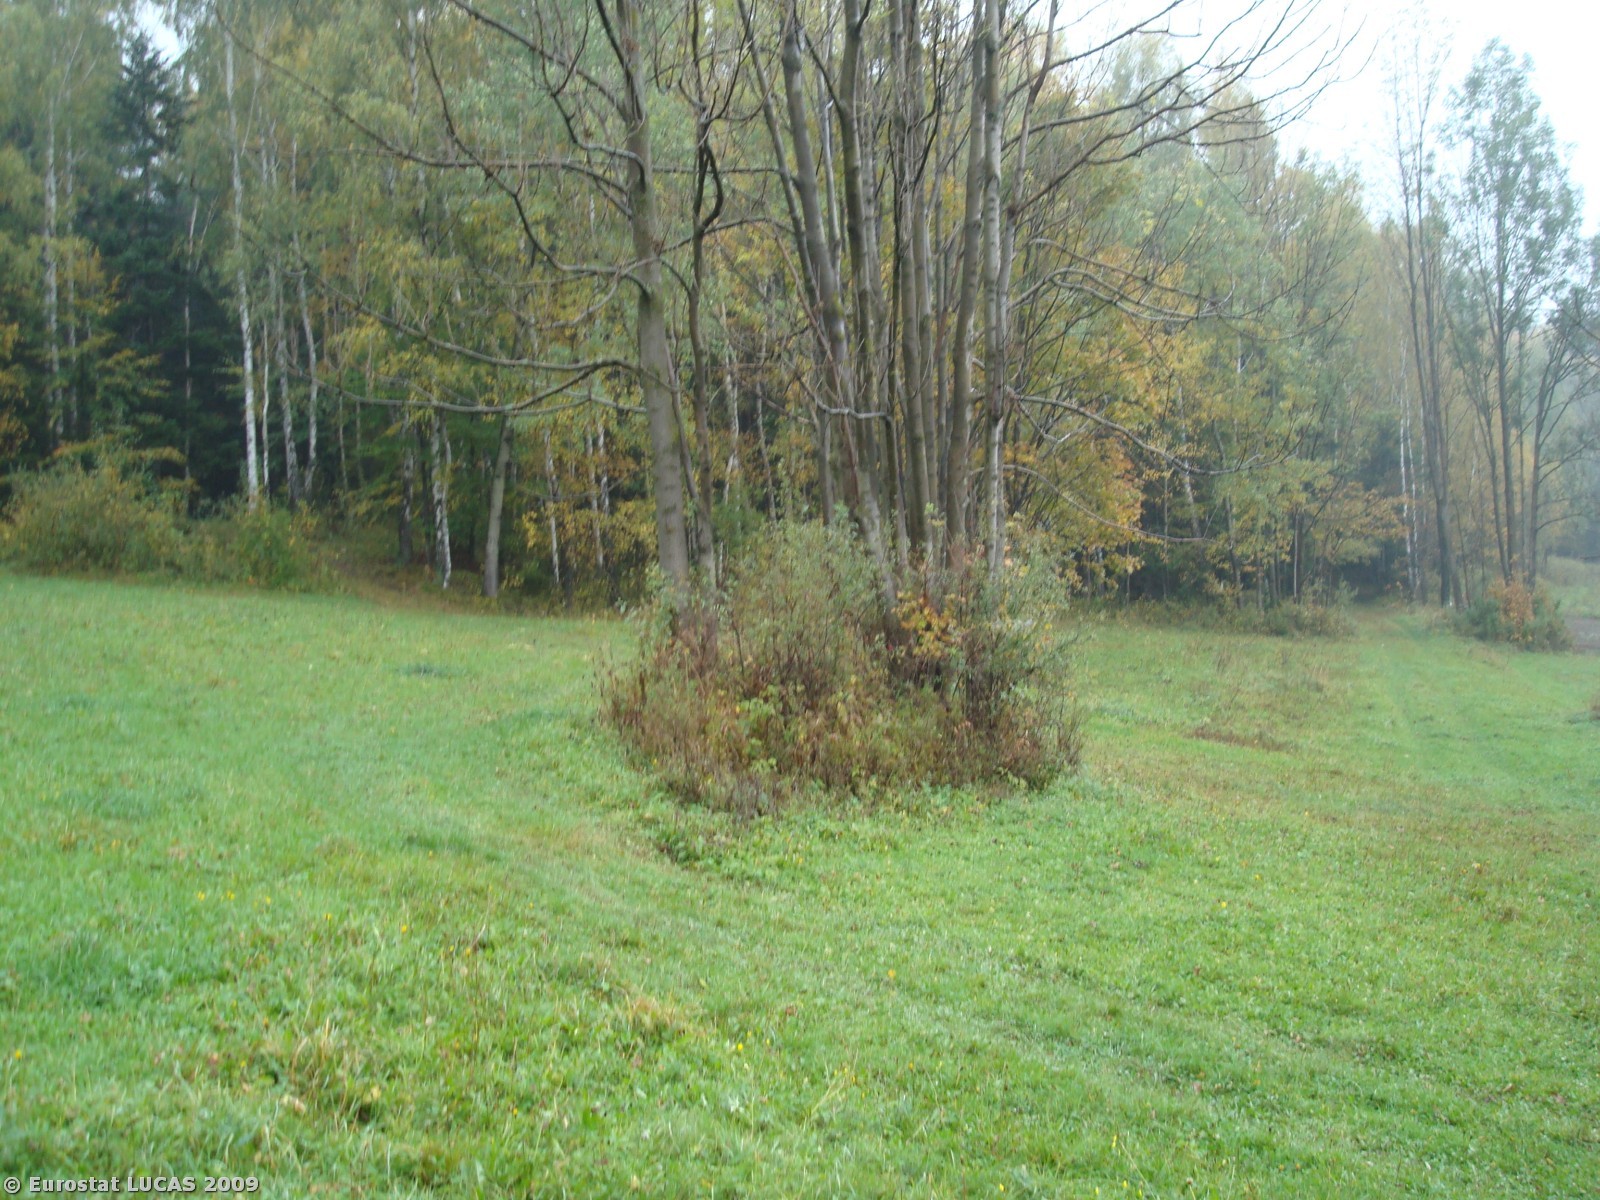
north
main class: Grassland
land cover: Grassland without tree/shrub cover
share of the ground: > 75 %
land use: Unused
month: September
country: PL
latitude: 49.6493
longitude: 19.6263
